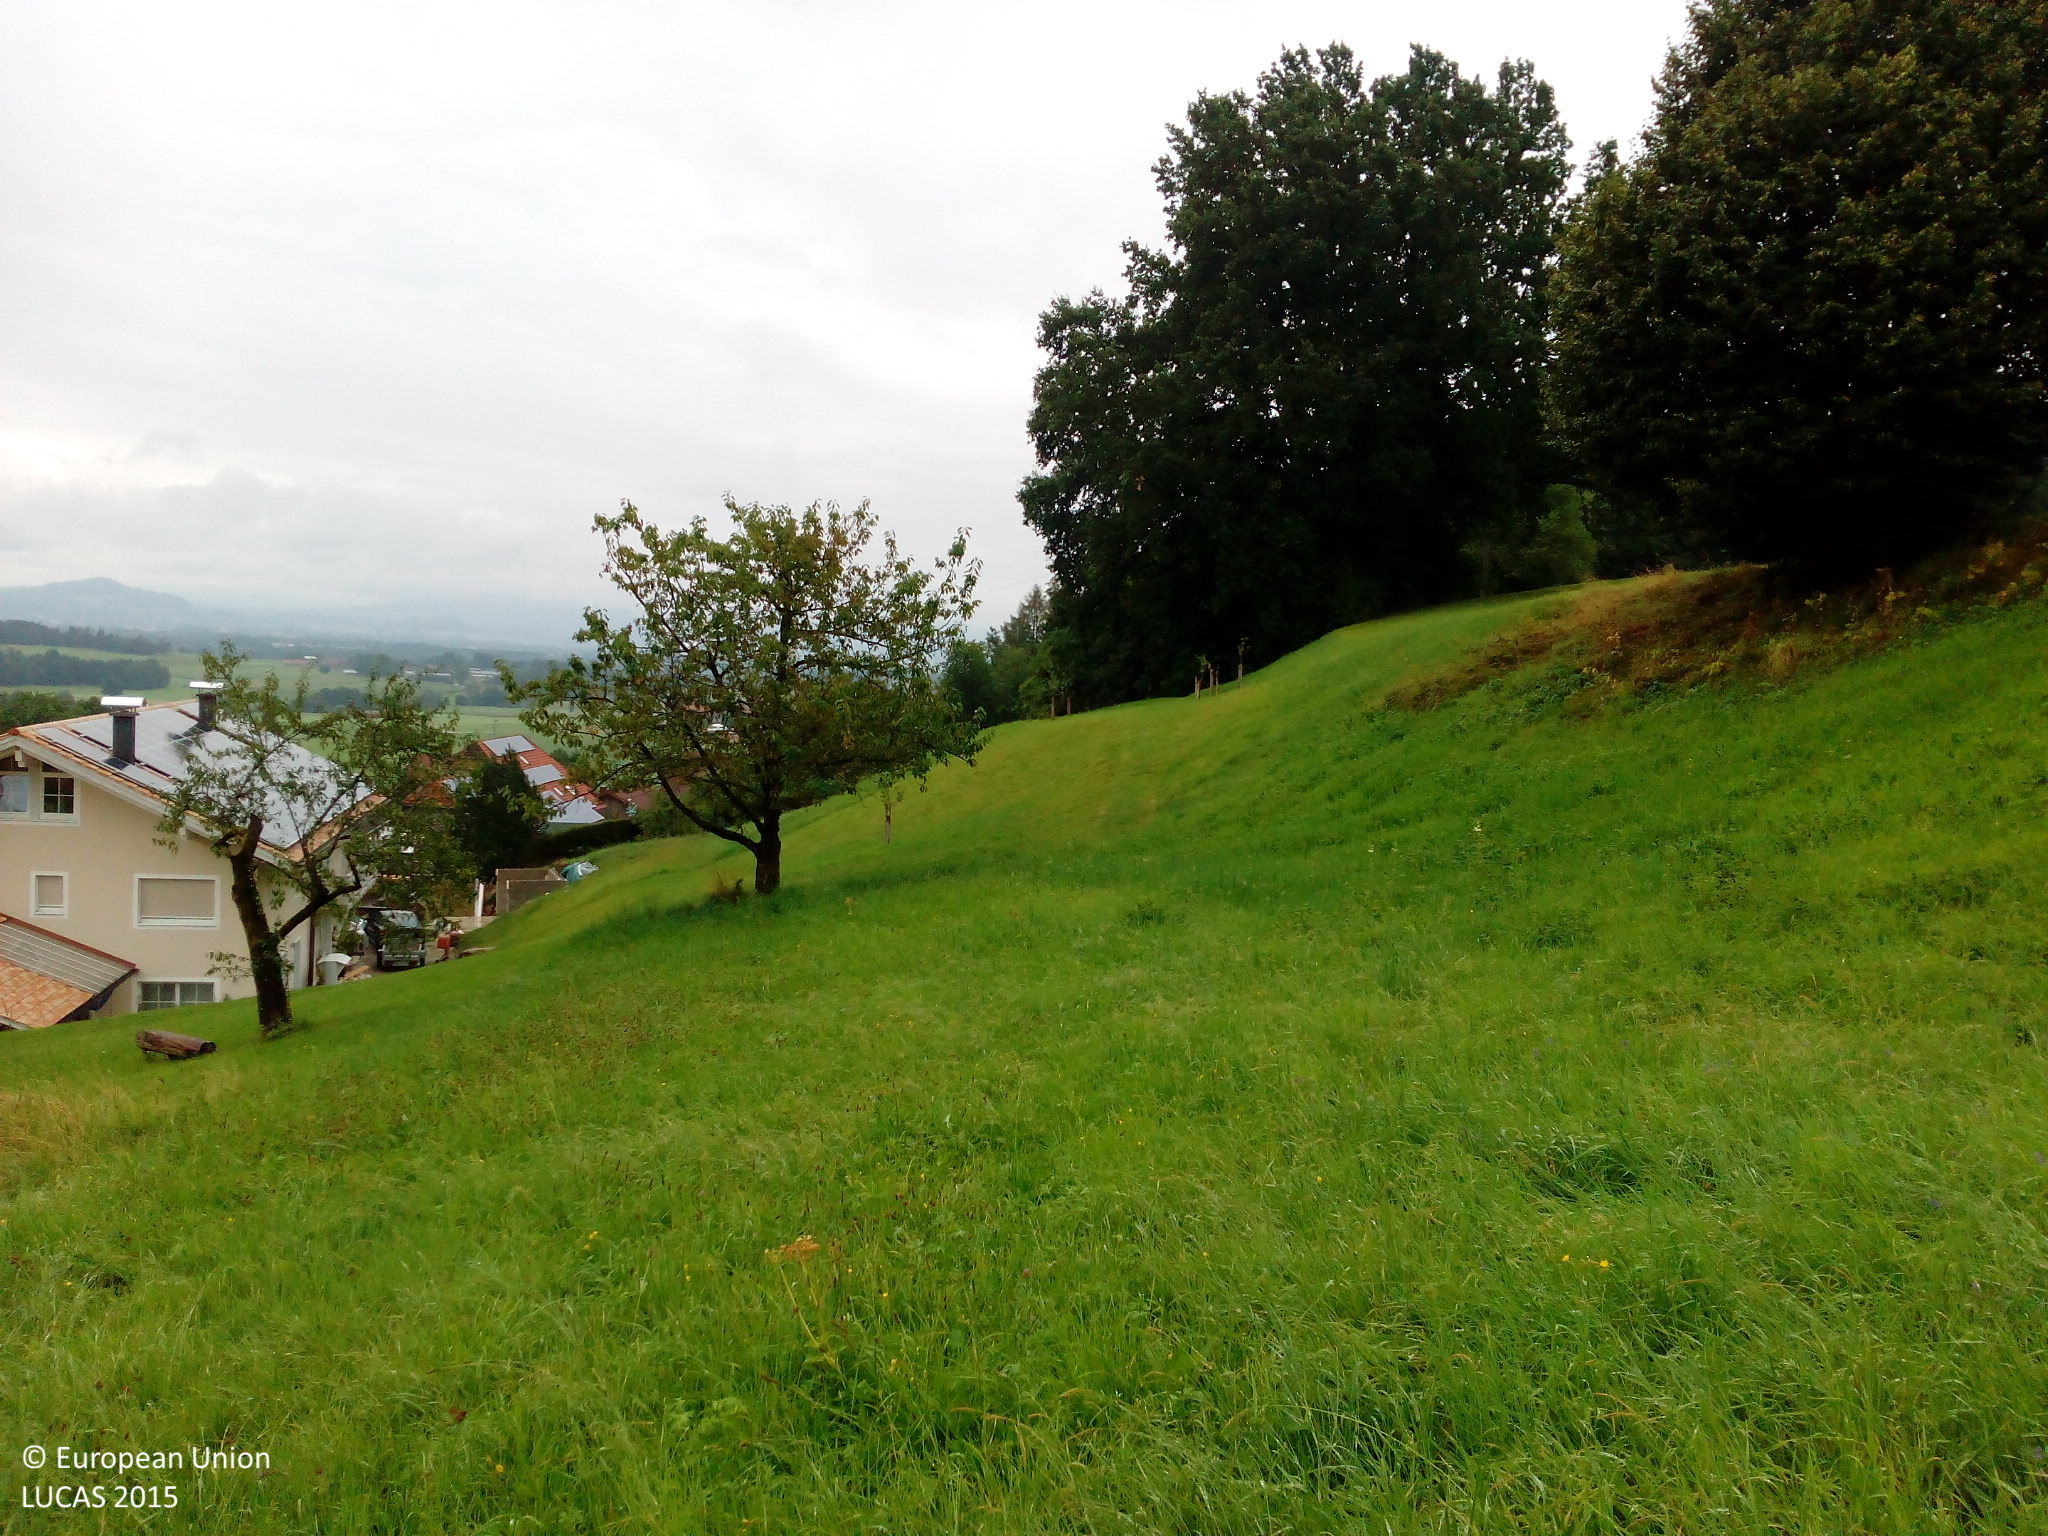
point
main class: Grassland
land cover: Grassland with sparse tree/shrub cover
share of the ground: > 75 %
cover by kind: herbaceous plants 95 %, broadleaved forest trees 5 %
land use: Residential
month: August
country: DE
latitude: 47.8260
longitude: 12.8706
